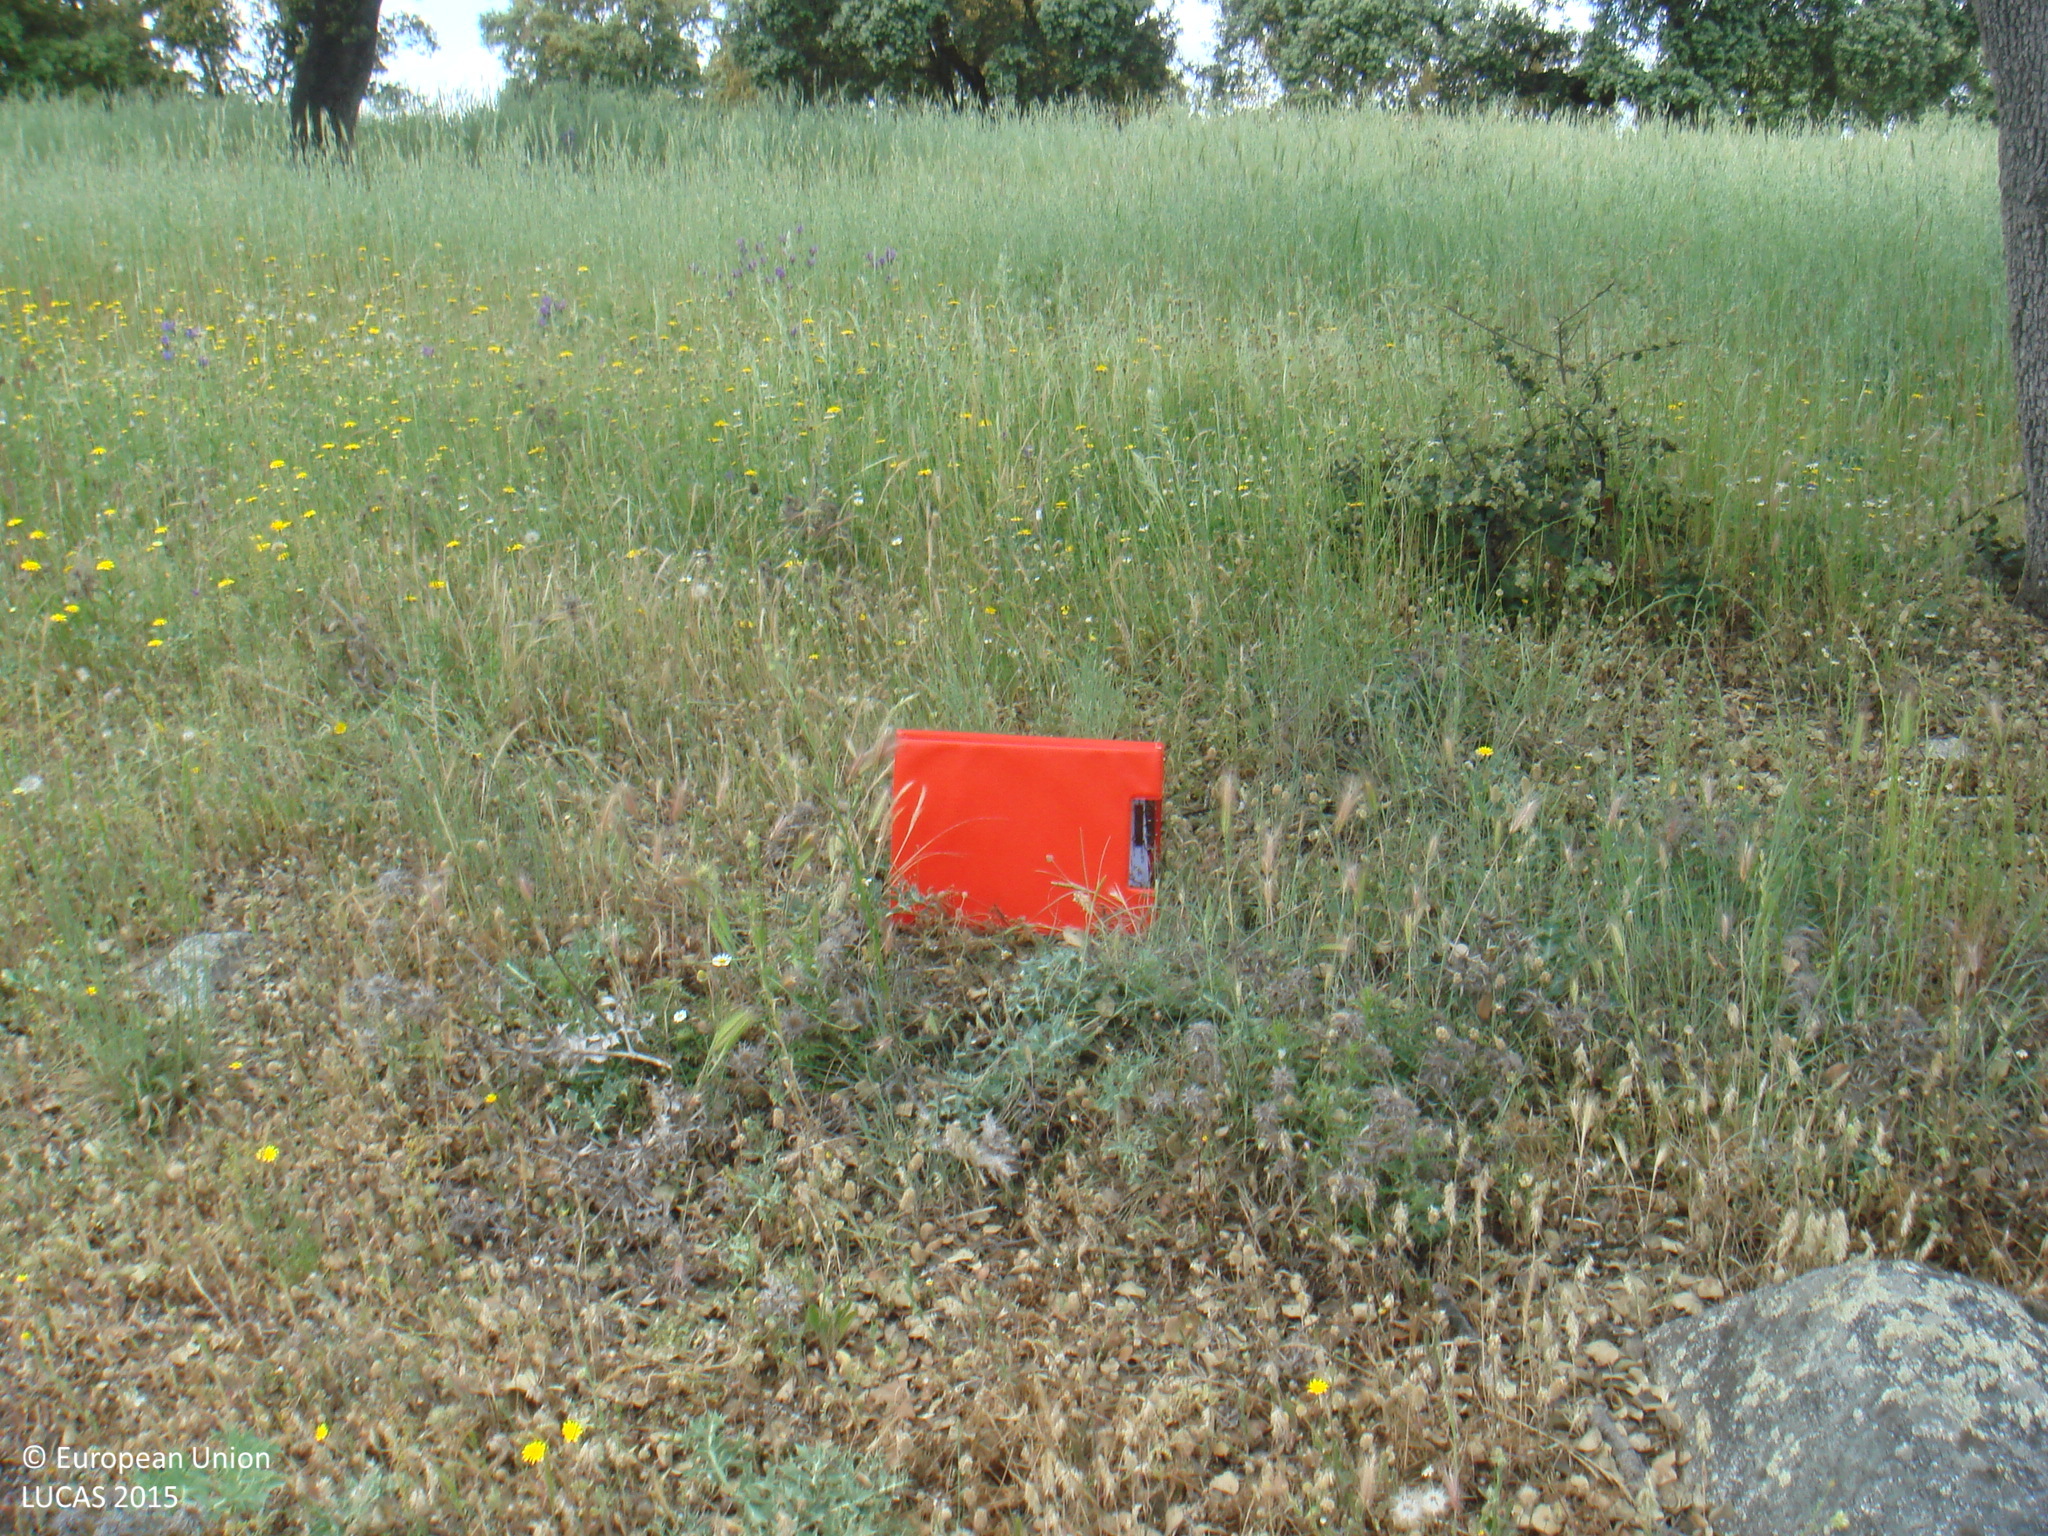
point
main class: Woodland
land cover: Broadleaved woodland
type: broadleaved evergreen forest
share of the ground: 10 - 25 %
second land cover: Spontaneously vegetated surfaces
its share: 50 - 75 %
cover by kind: herbaceous plants 70 %, broadleaved forest trees 20 %, shrubs 10 %
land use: Forestry
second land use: Agriculture (excluding fallow land and kitchen gardens)
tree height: > 5 m
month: May
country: ES
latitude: 38.4053
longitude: -4.6676
